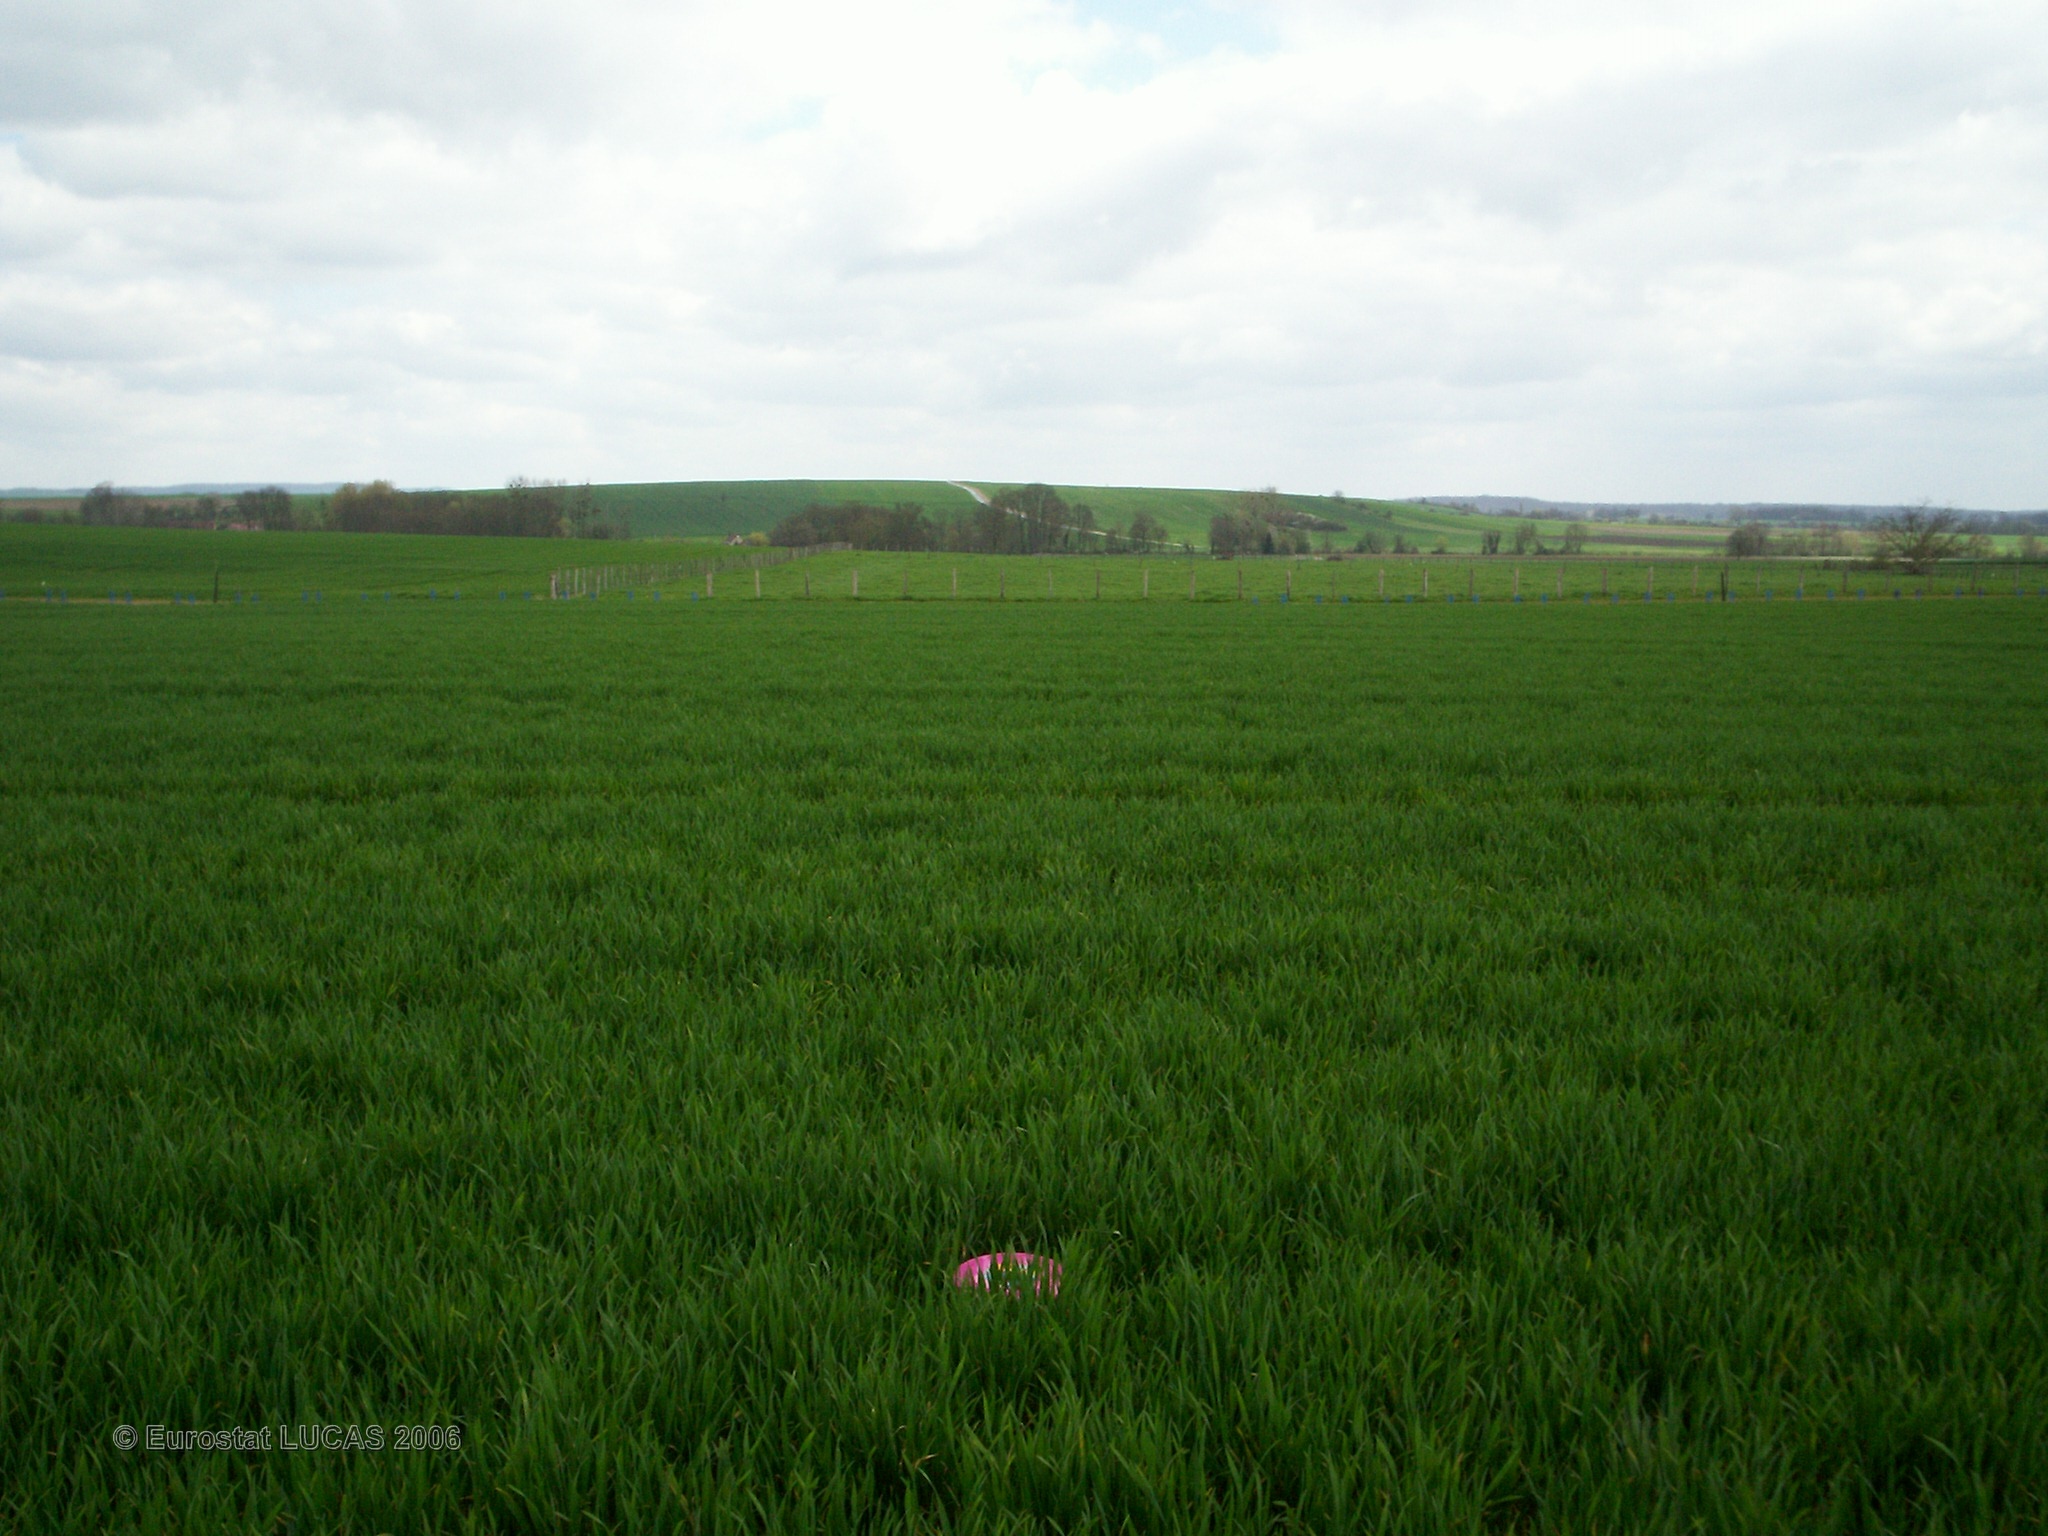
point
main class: Cropland
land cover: Common wheat
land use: Agriculture (excluding fallow land and kitchen gardens)
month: April
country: FR
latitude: 48.0497
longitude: 3.8115
